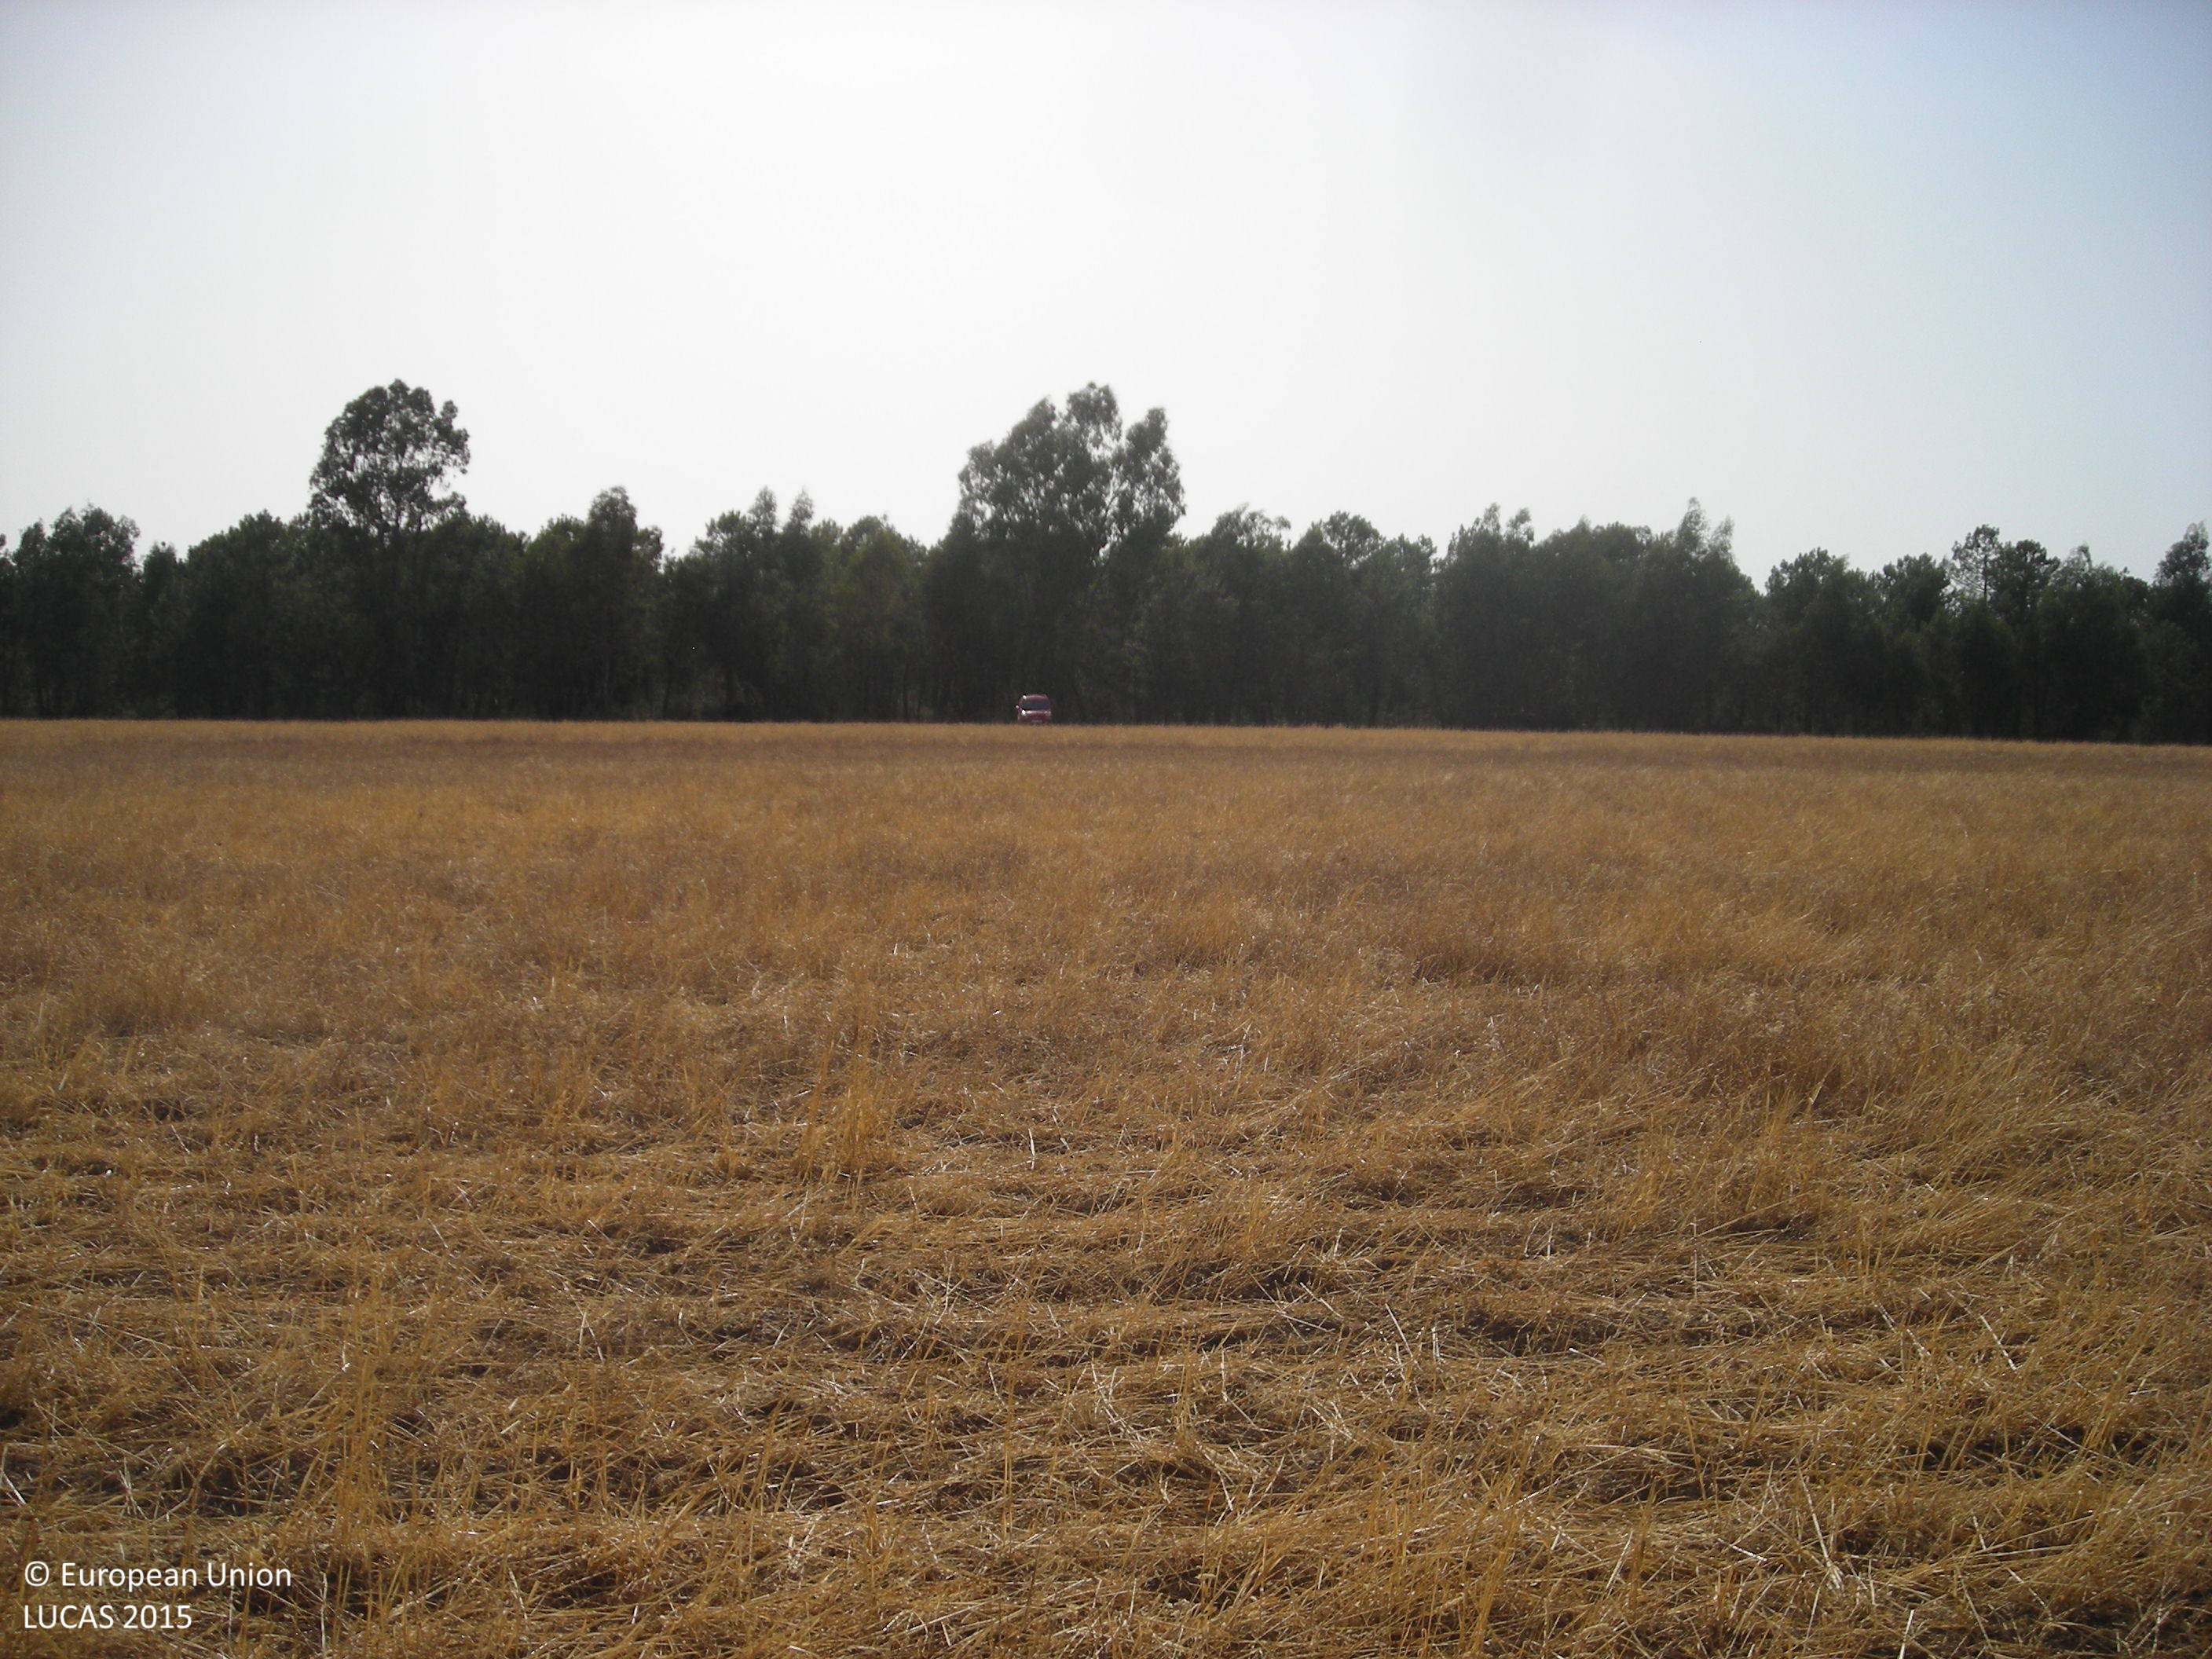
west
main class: Grassland
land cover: Grassland without tree/shrub cover
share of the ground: > 75 %
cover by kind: herbaceous plants 100 %
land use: Agriculture (excluding fallow land and kitchen gardens)
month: July
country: ES
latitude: 39.3097
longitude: -5.3431
